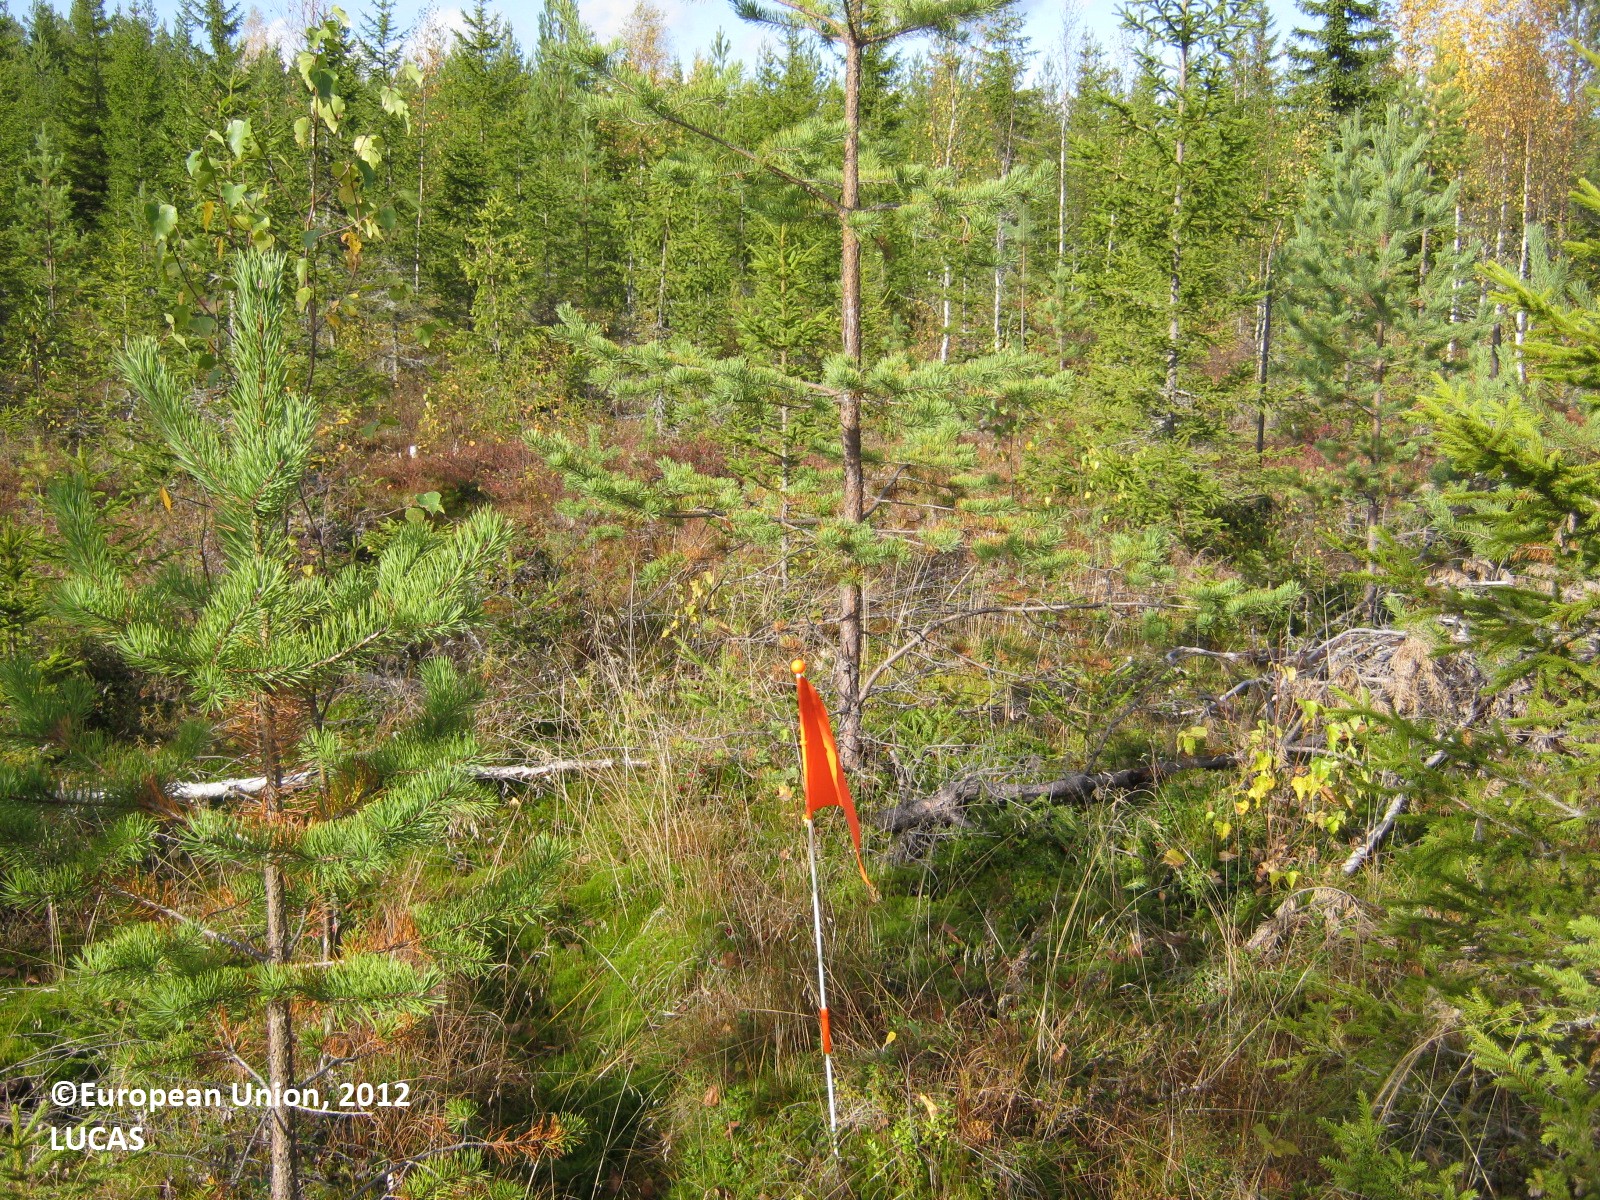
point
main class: Woodland
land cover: Other mixed woodland
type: boreal forest
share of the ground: 50 - 75 %
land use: Forestry
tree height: < 5 m
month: September
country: FI
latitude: 62.2919
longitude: 28.8991
